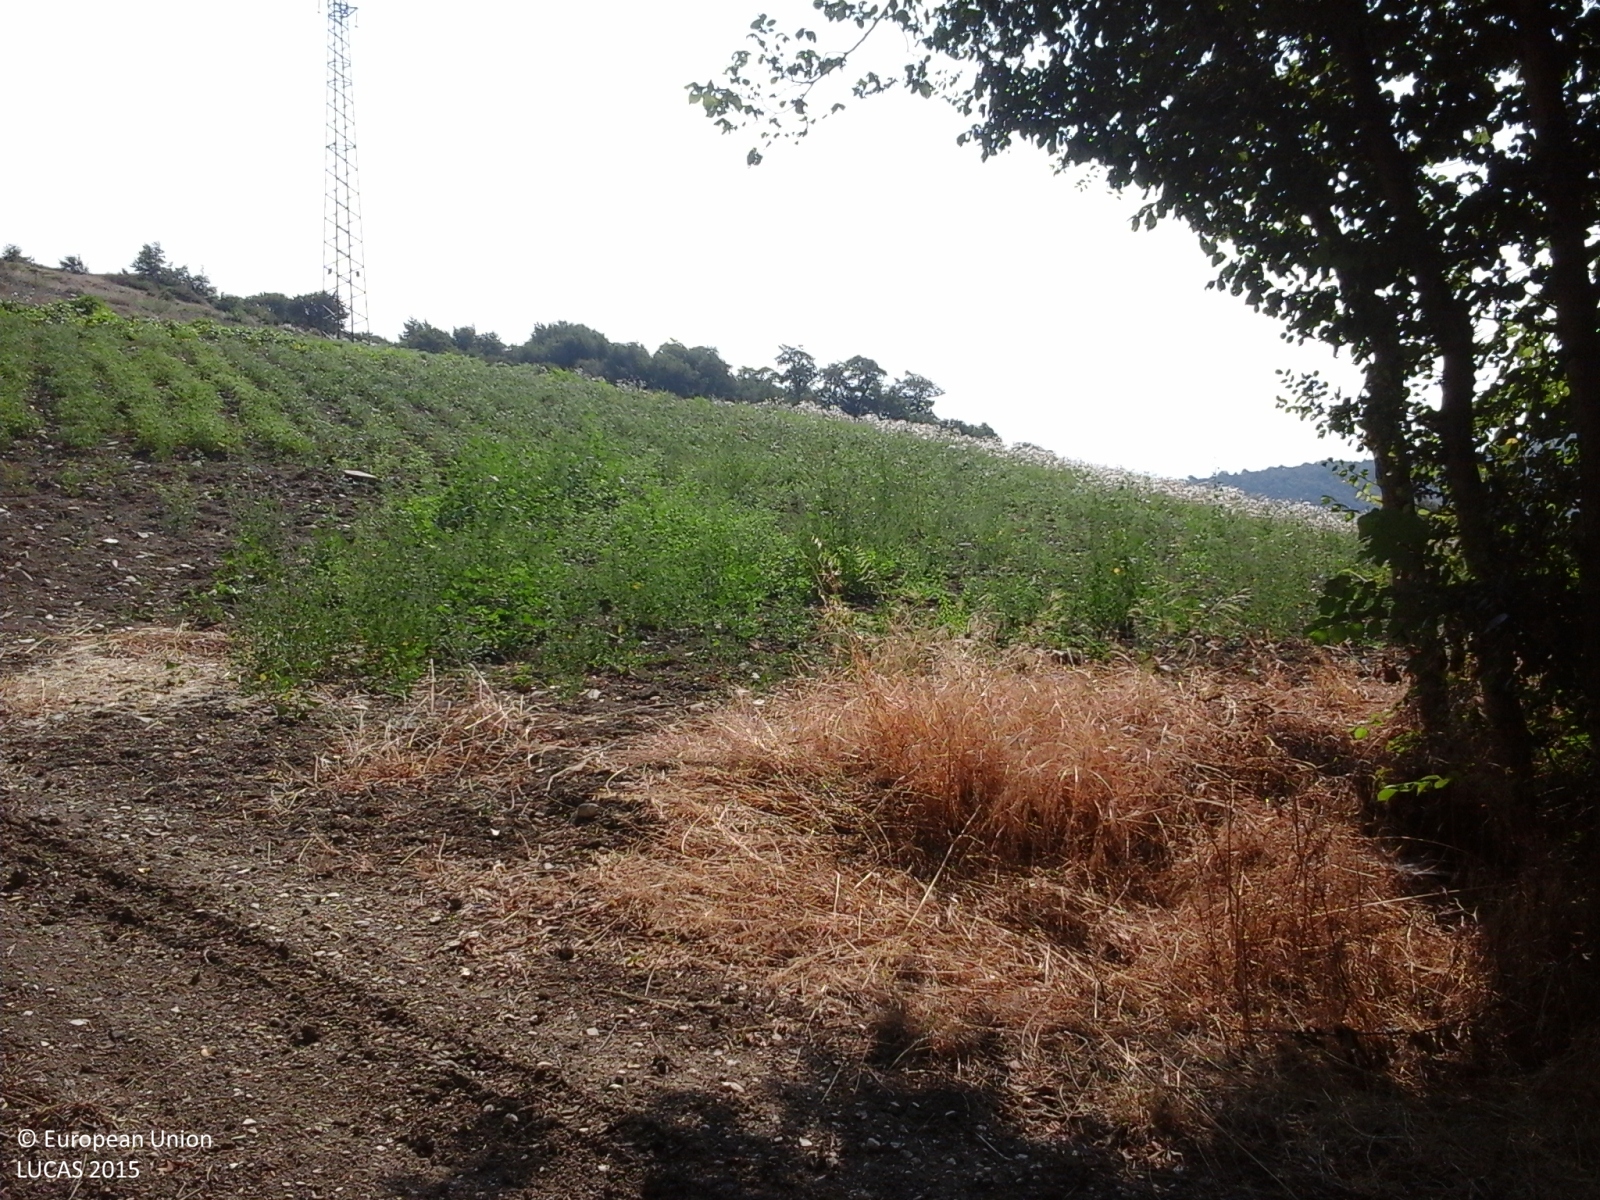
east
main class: Woodland
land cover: Broadleaved woodland
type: thermophilous deciduous forest
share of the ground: > 75 %
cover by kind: broadleaved forest trees 90 %, shrubs 5 %, herbaceous plants 5 %
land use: Forestry
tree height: > 5 m
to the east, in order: Broadleaved woodland; Grass margins; Tracks; Other bare soil; Spontaneously vegetated surfaces; Tomatoes; Other fresh vegetables; Dry pulses; Spontaneously vegetated surfaces; Electric lines; Spontaneously vegetated surfaces; Shrubland with sparse tree cover; Other bare soil; Common wheat; Other structural elements; Grass margins; Tracks; Broadleaved woodland
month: August
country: IT
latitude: 41.4386
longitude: 15.1168
